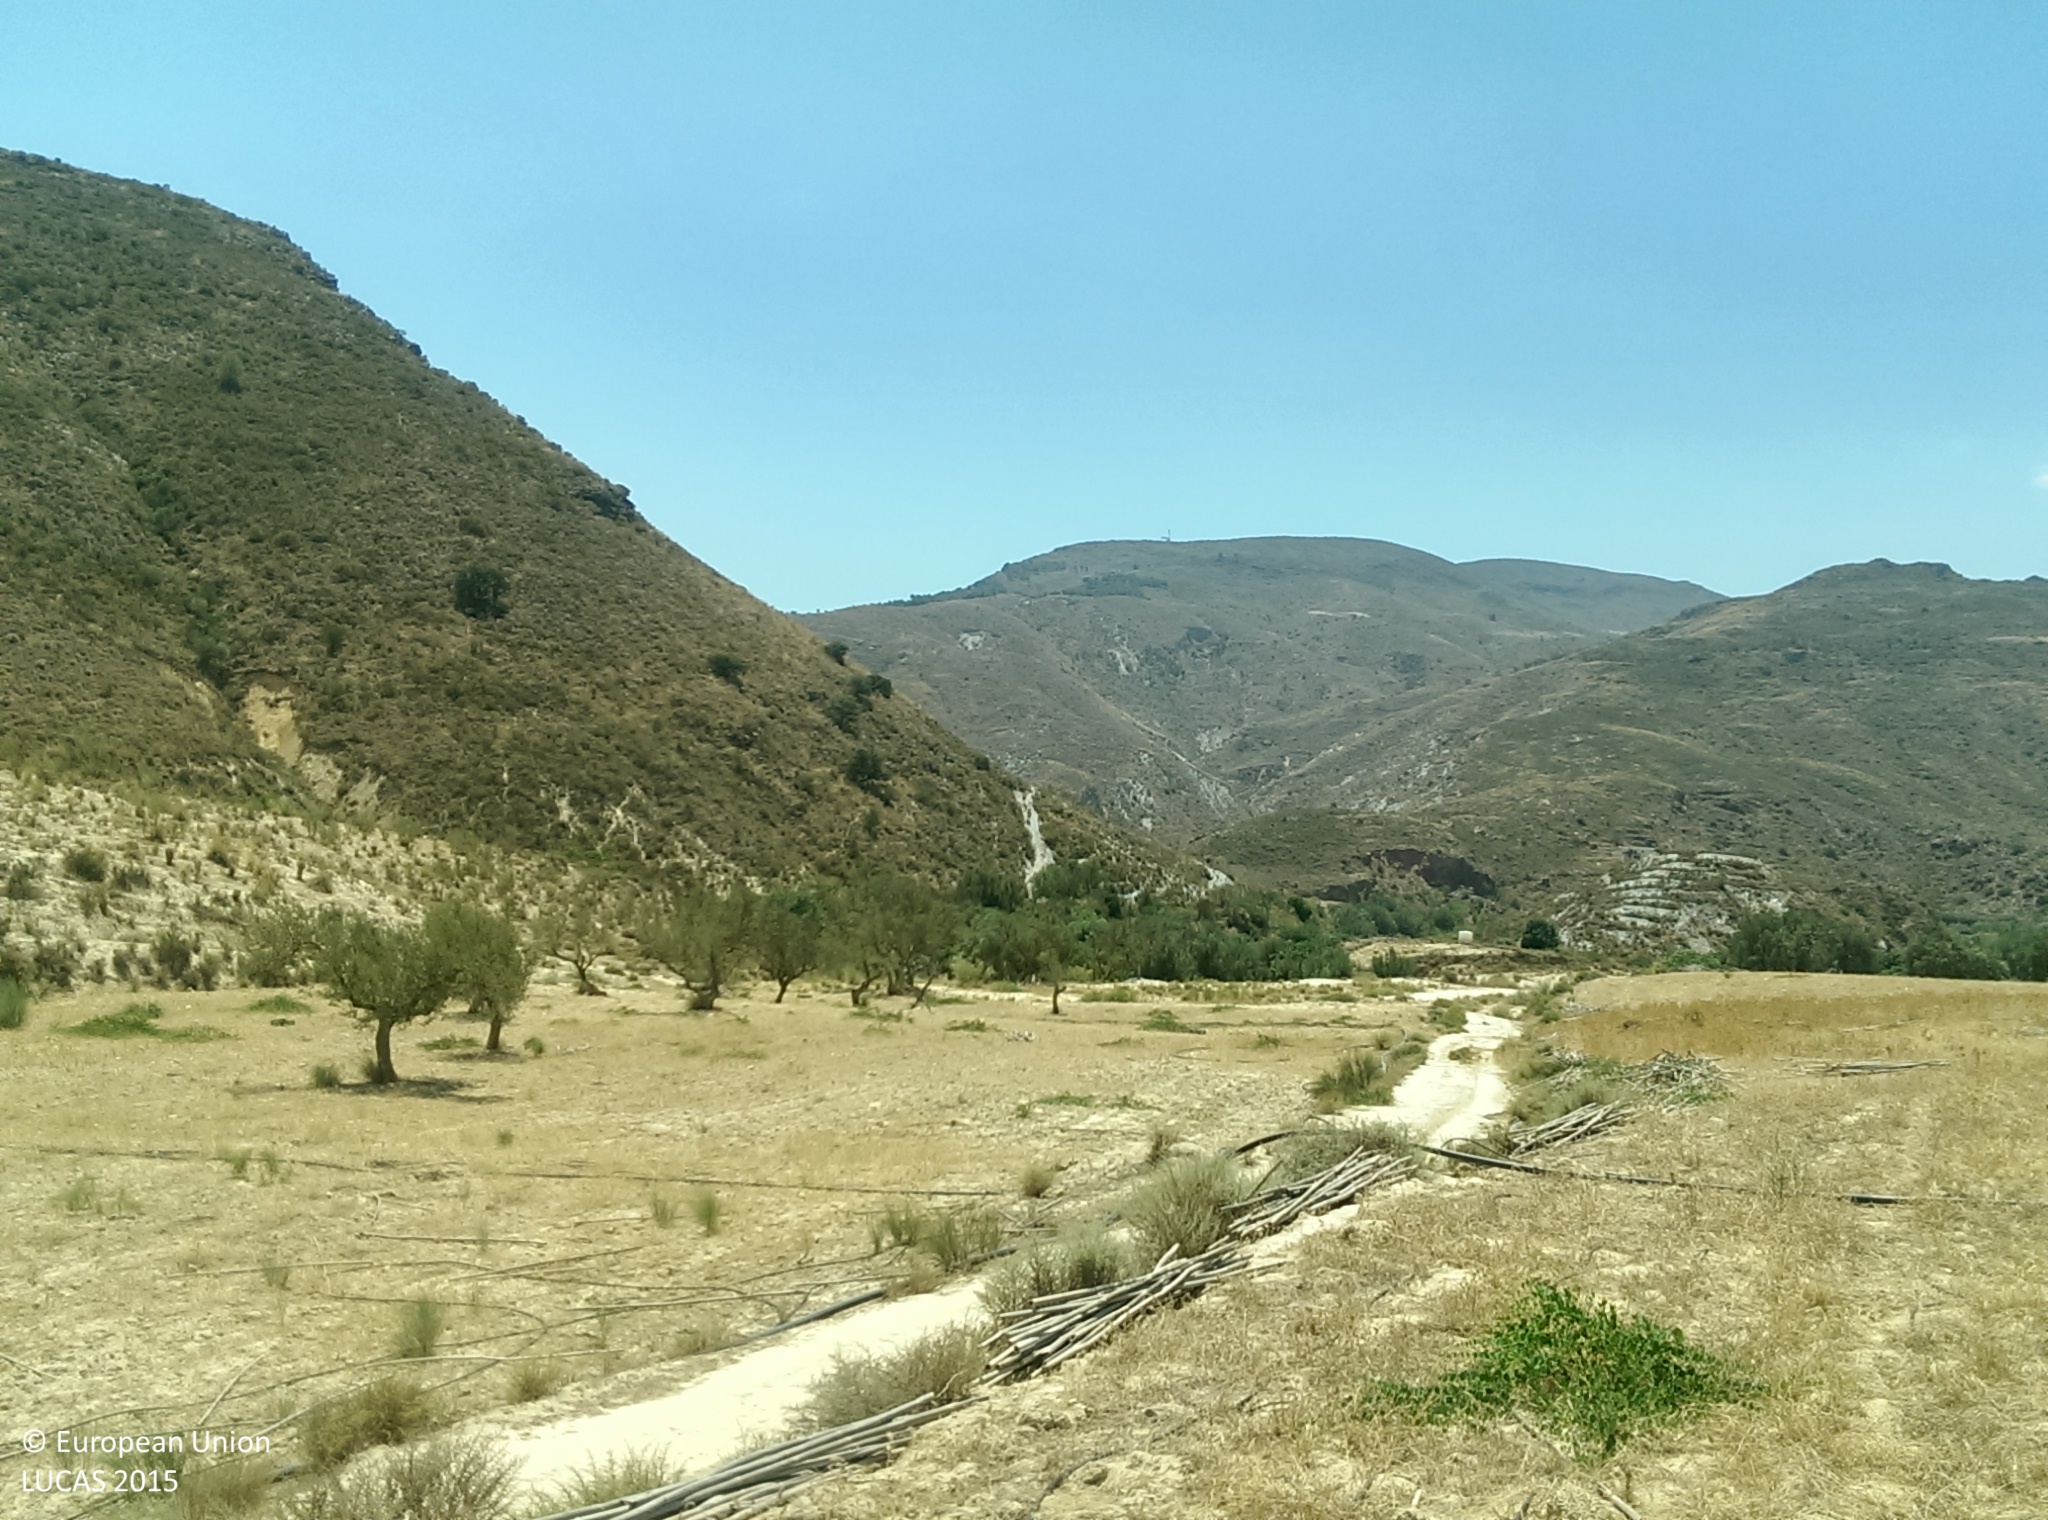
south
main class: Grassland
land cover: Spontaneously vegetated surfaces
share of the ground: 50 - 75 %
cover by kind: herbaceous plants 70 %, unconsolidated bare surface 30 %
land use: Fallow land
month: July
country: ES
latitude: 36.9374
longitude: -3.0386
